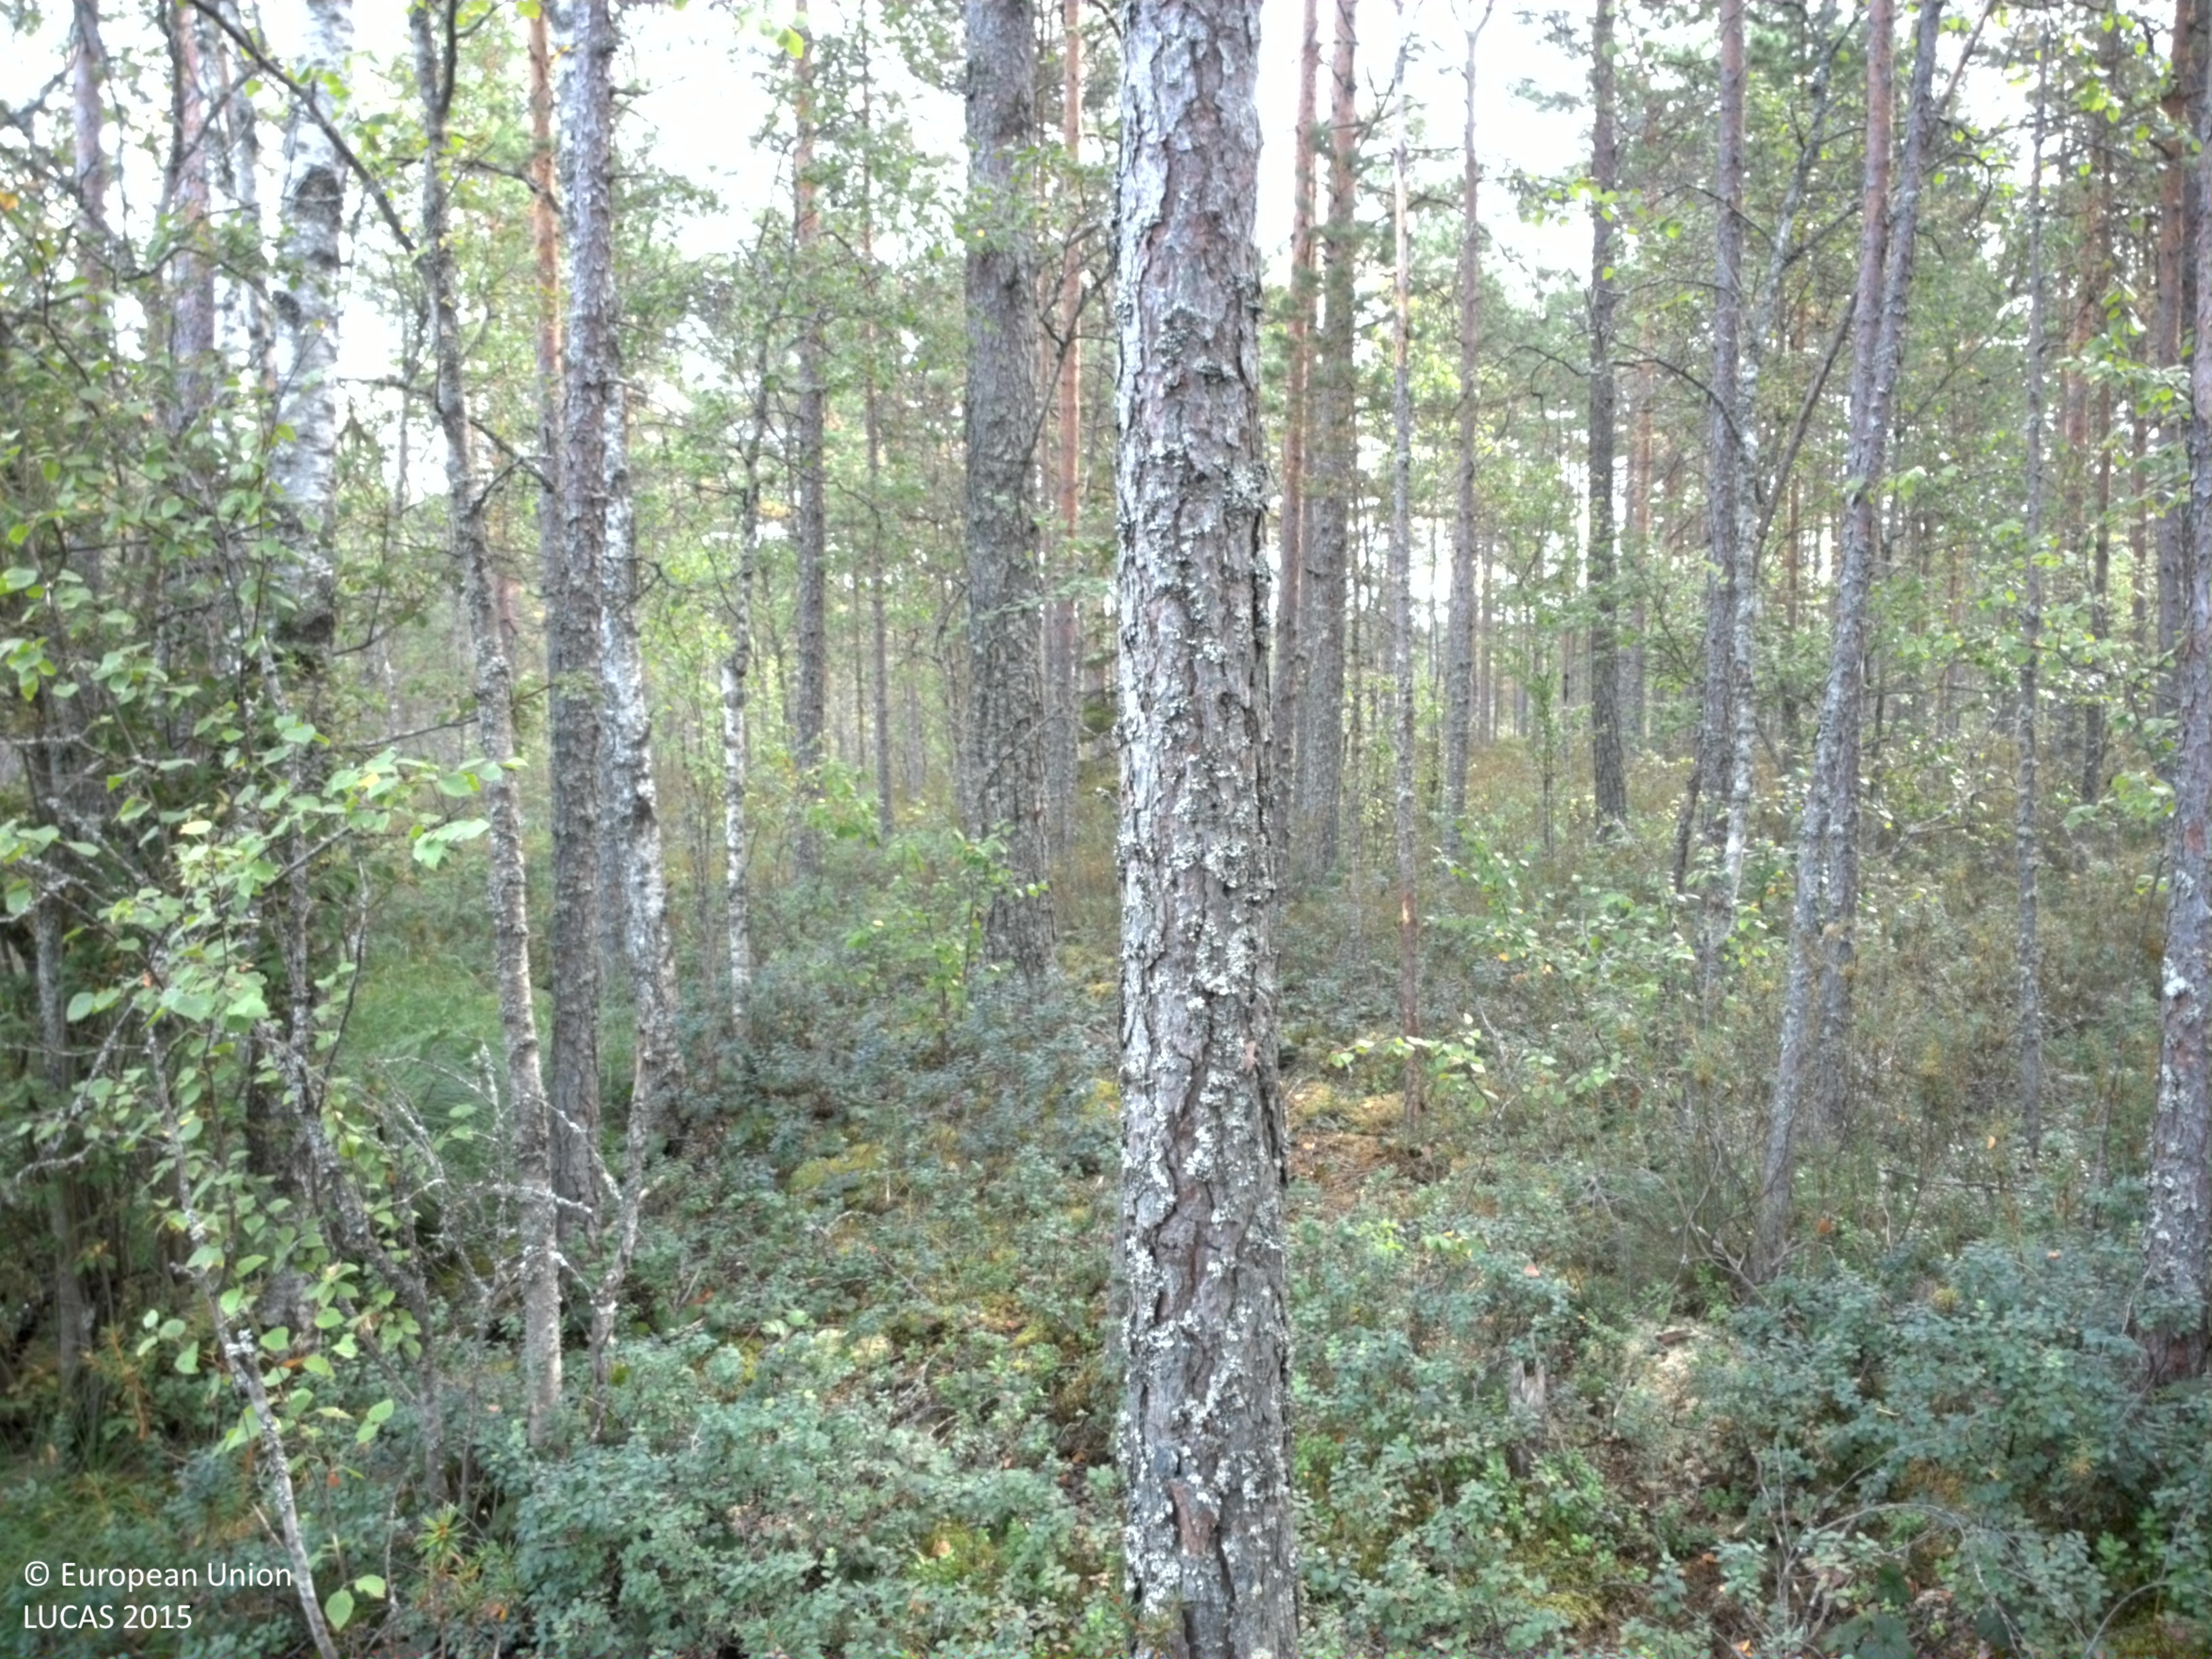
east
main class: Woodland
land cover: Pine dominated coniferous woodland
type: boreal forest
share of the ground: 50 - 75 %
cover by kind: coniferous forest trees 55 %, shrubs 20 %, broadleaved forest trees 10 %, lichens and mosses 10 %, herbaceous plants 5 %
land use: Forestry
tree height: > 5 m
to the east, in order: Pine dominated coniferous woodland; Ditches and canals; Broadleaved woodland; Ditches and canals; Spontaneously vegetated surfaces; Rocks and stones; Railways; Electric lines; Rocks and stones
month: August
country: SE
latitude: 59.5801
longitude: 13.4445
